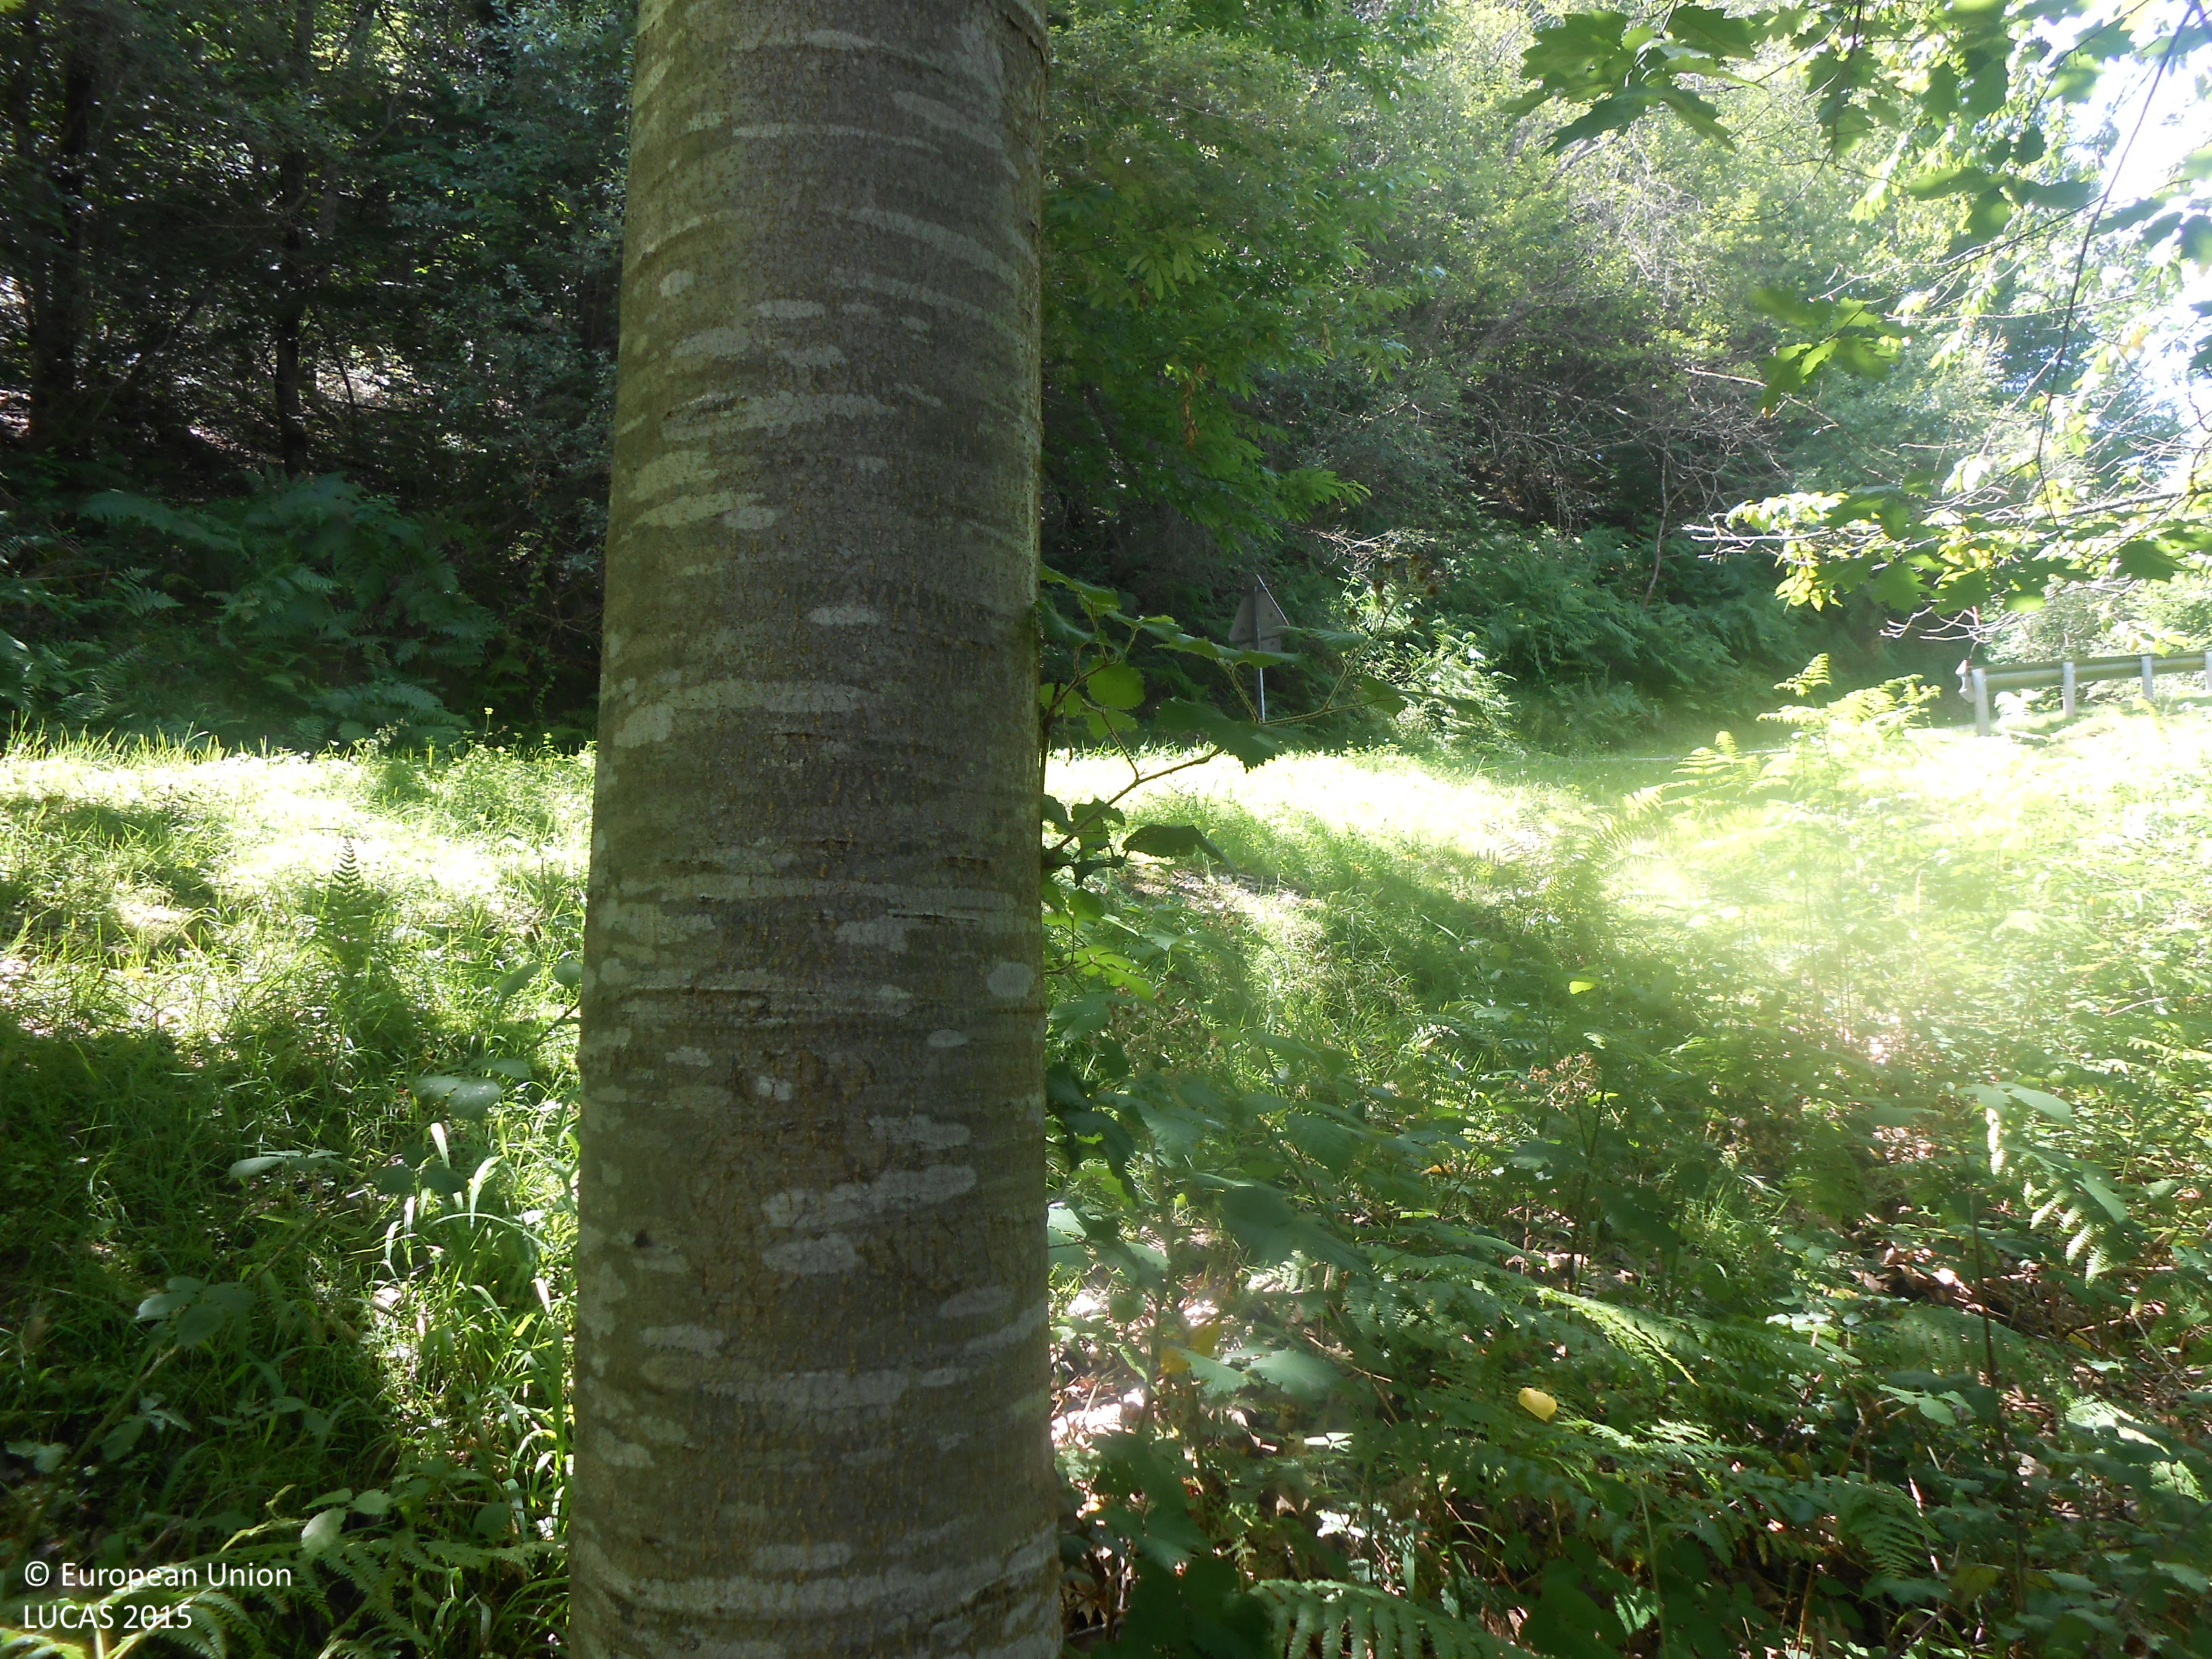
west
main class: Woodland
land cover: Broadleaved woodland
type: acidophilous oak and oak-birch forest
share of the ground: > 75 %
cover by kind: broadleaved forest trees 95 %, herbaceous plants 5 %
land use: Forestry
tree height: > 5 m
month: June
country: ES
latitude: 43.1910
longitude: -1.5713
